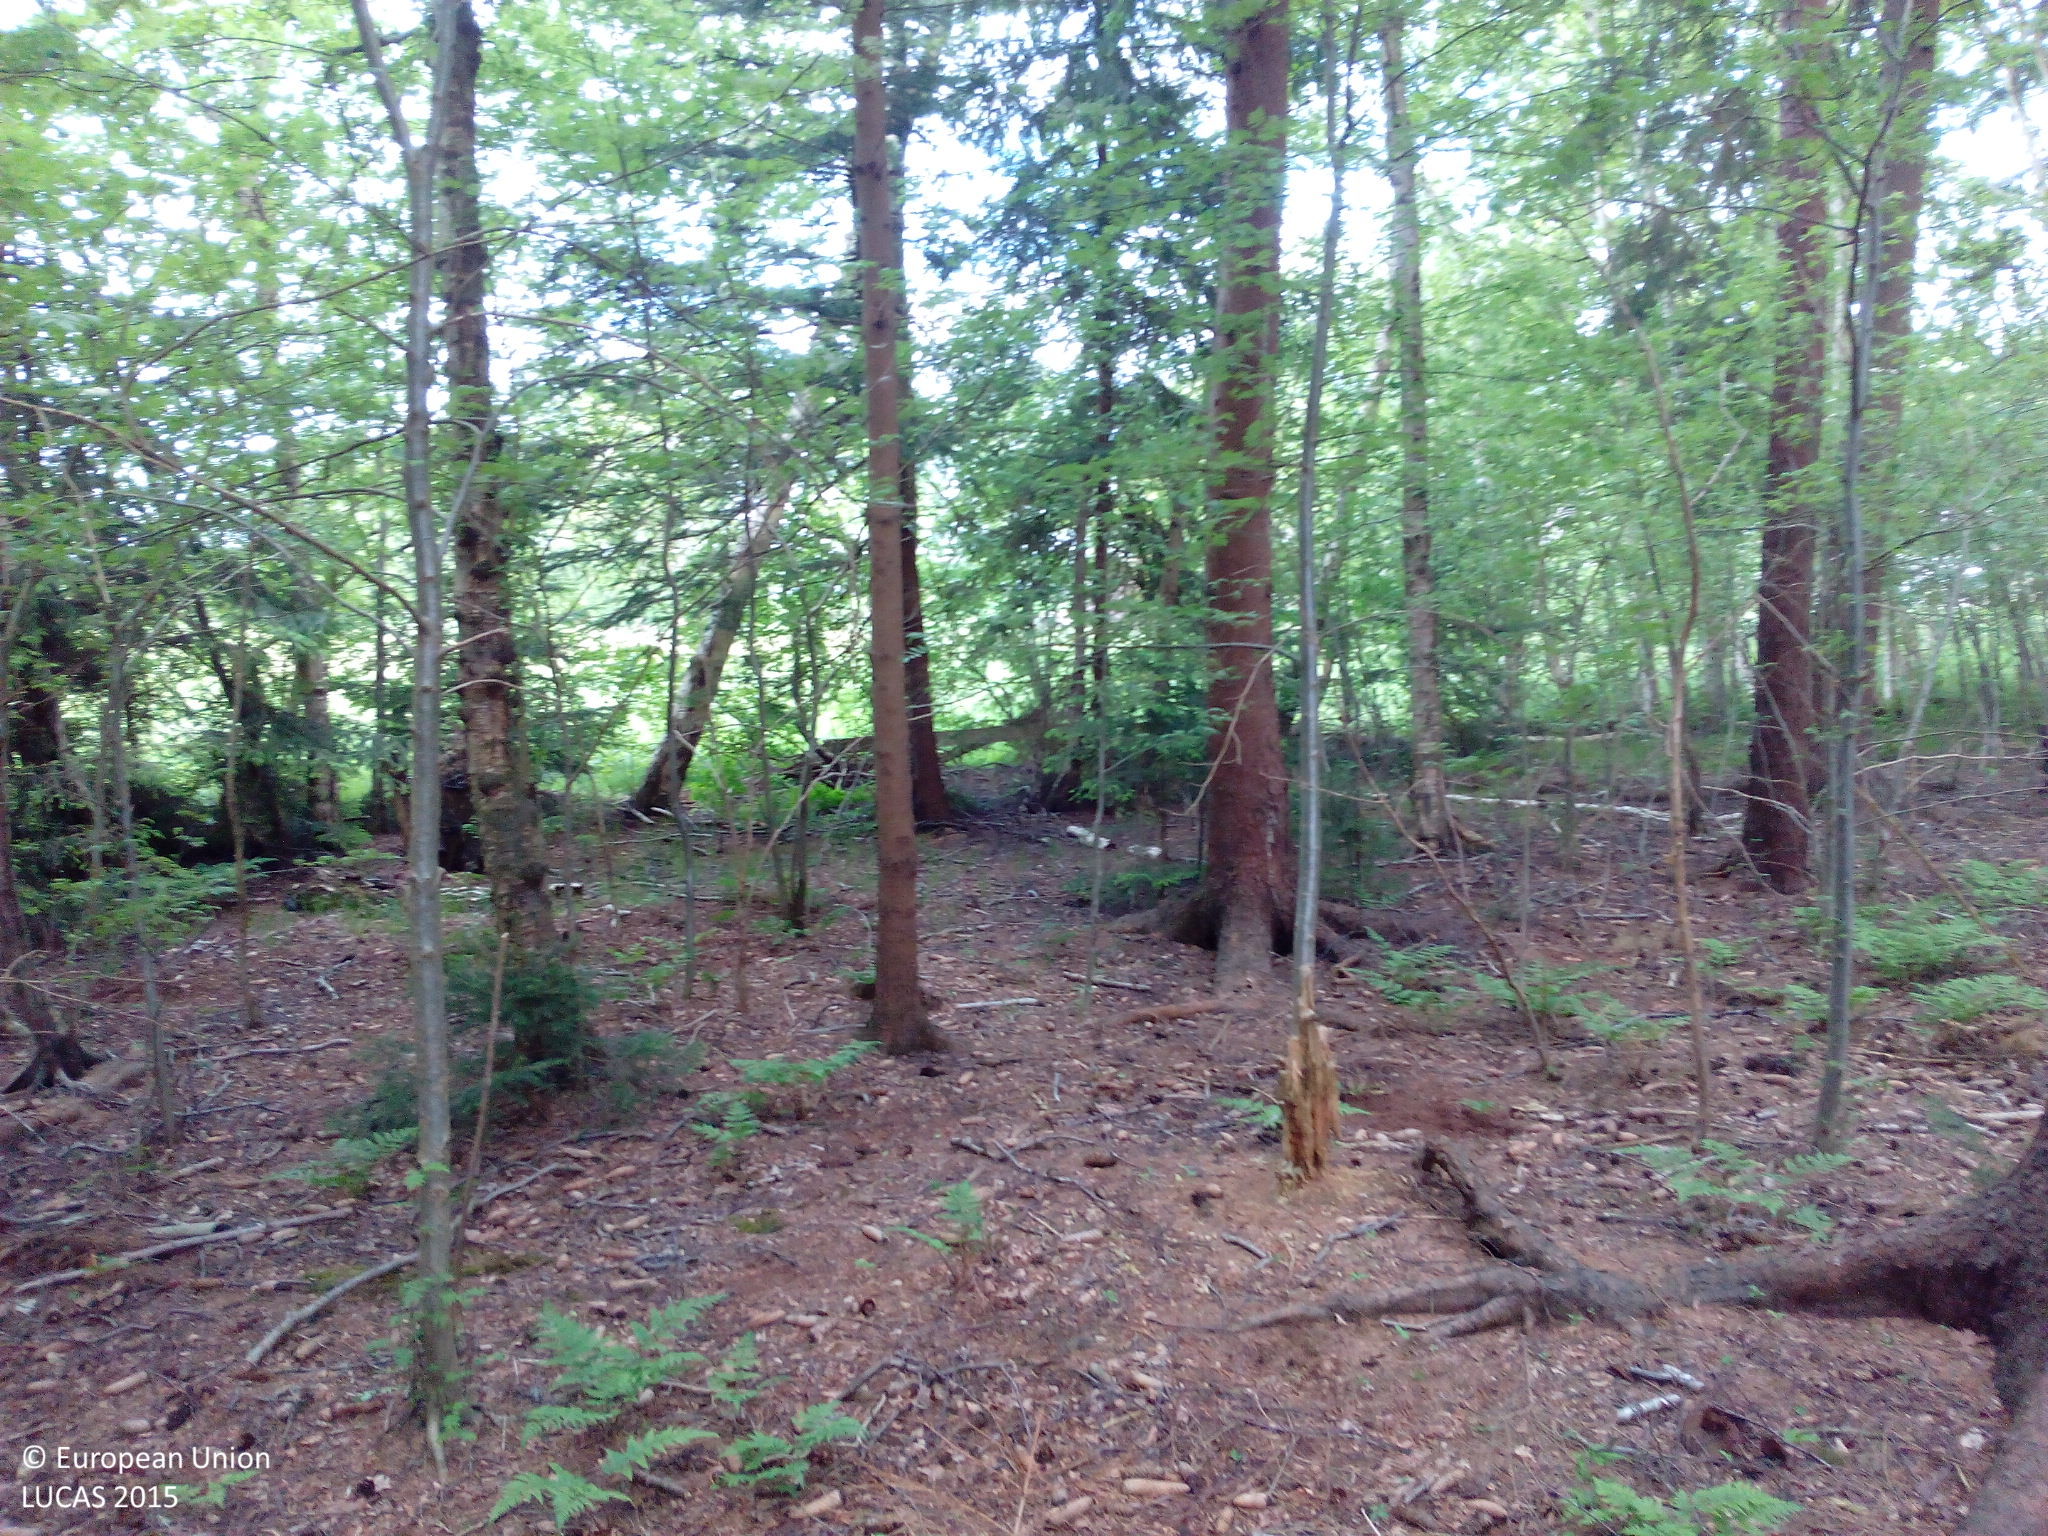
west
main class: Woodland
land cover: Spruce dominated mixed woodland
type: hemiboreal forest and nemoral coniferous forest and mixed broadleaved-coniferous forest
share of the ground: > 75 %
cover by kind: coniferous forest trees 65 %, broadleaved forest trees 30 %, herbaceous plants 5 %
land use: Residential
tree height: > 5 m
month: May
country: DE
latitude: 53.0397
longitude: 9.1801
